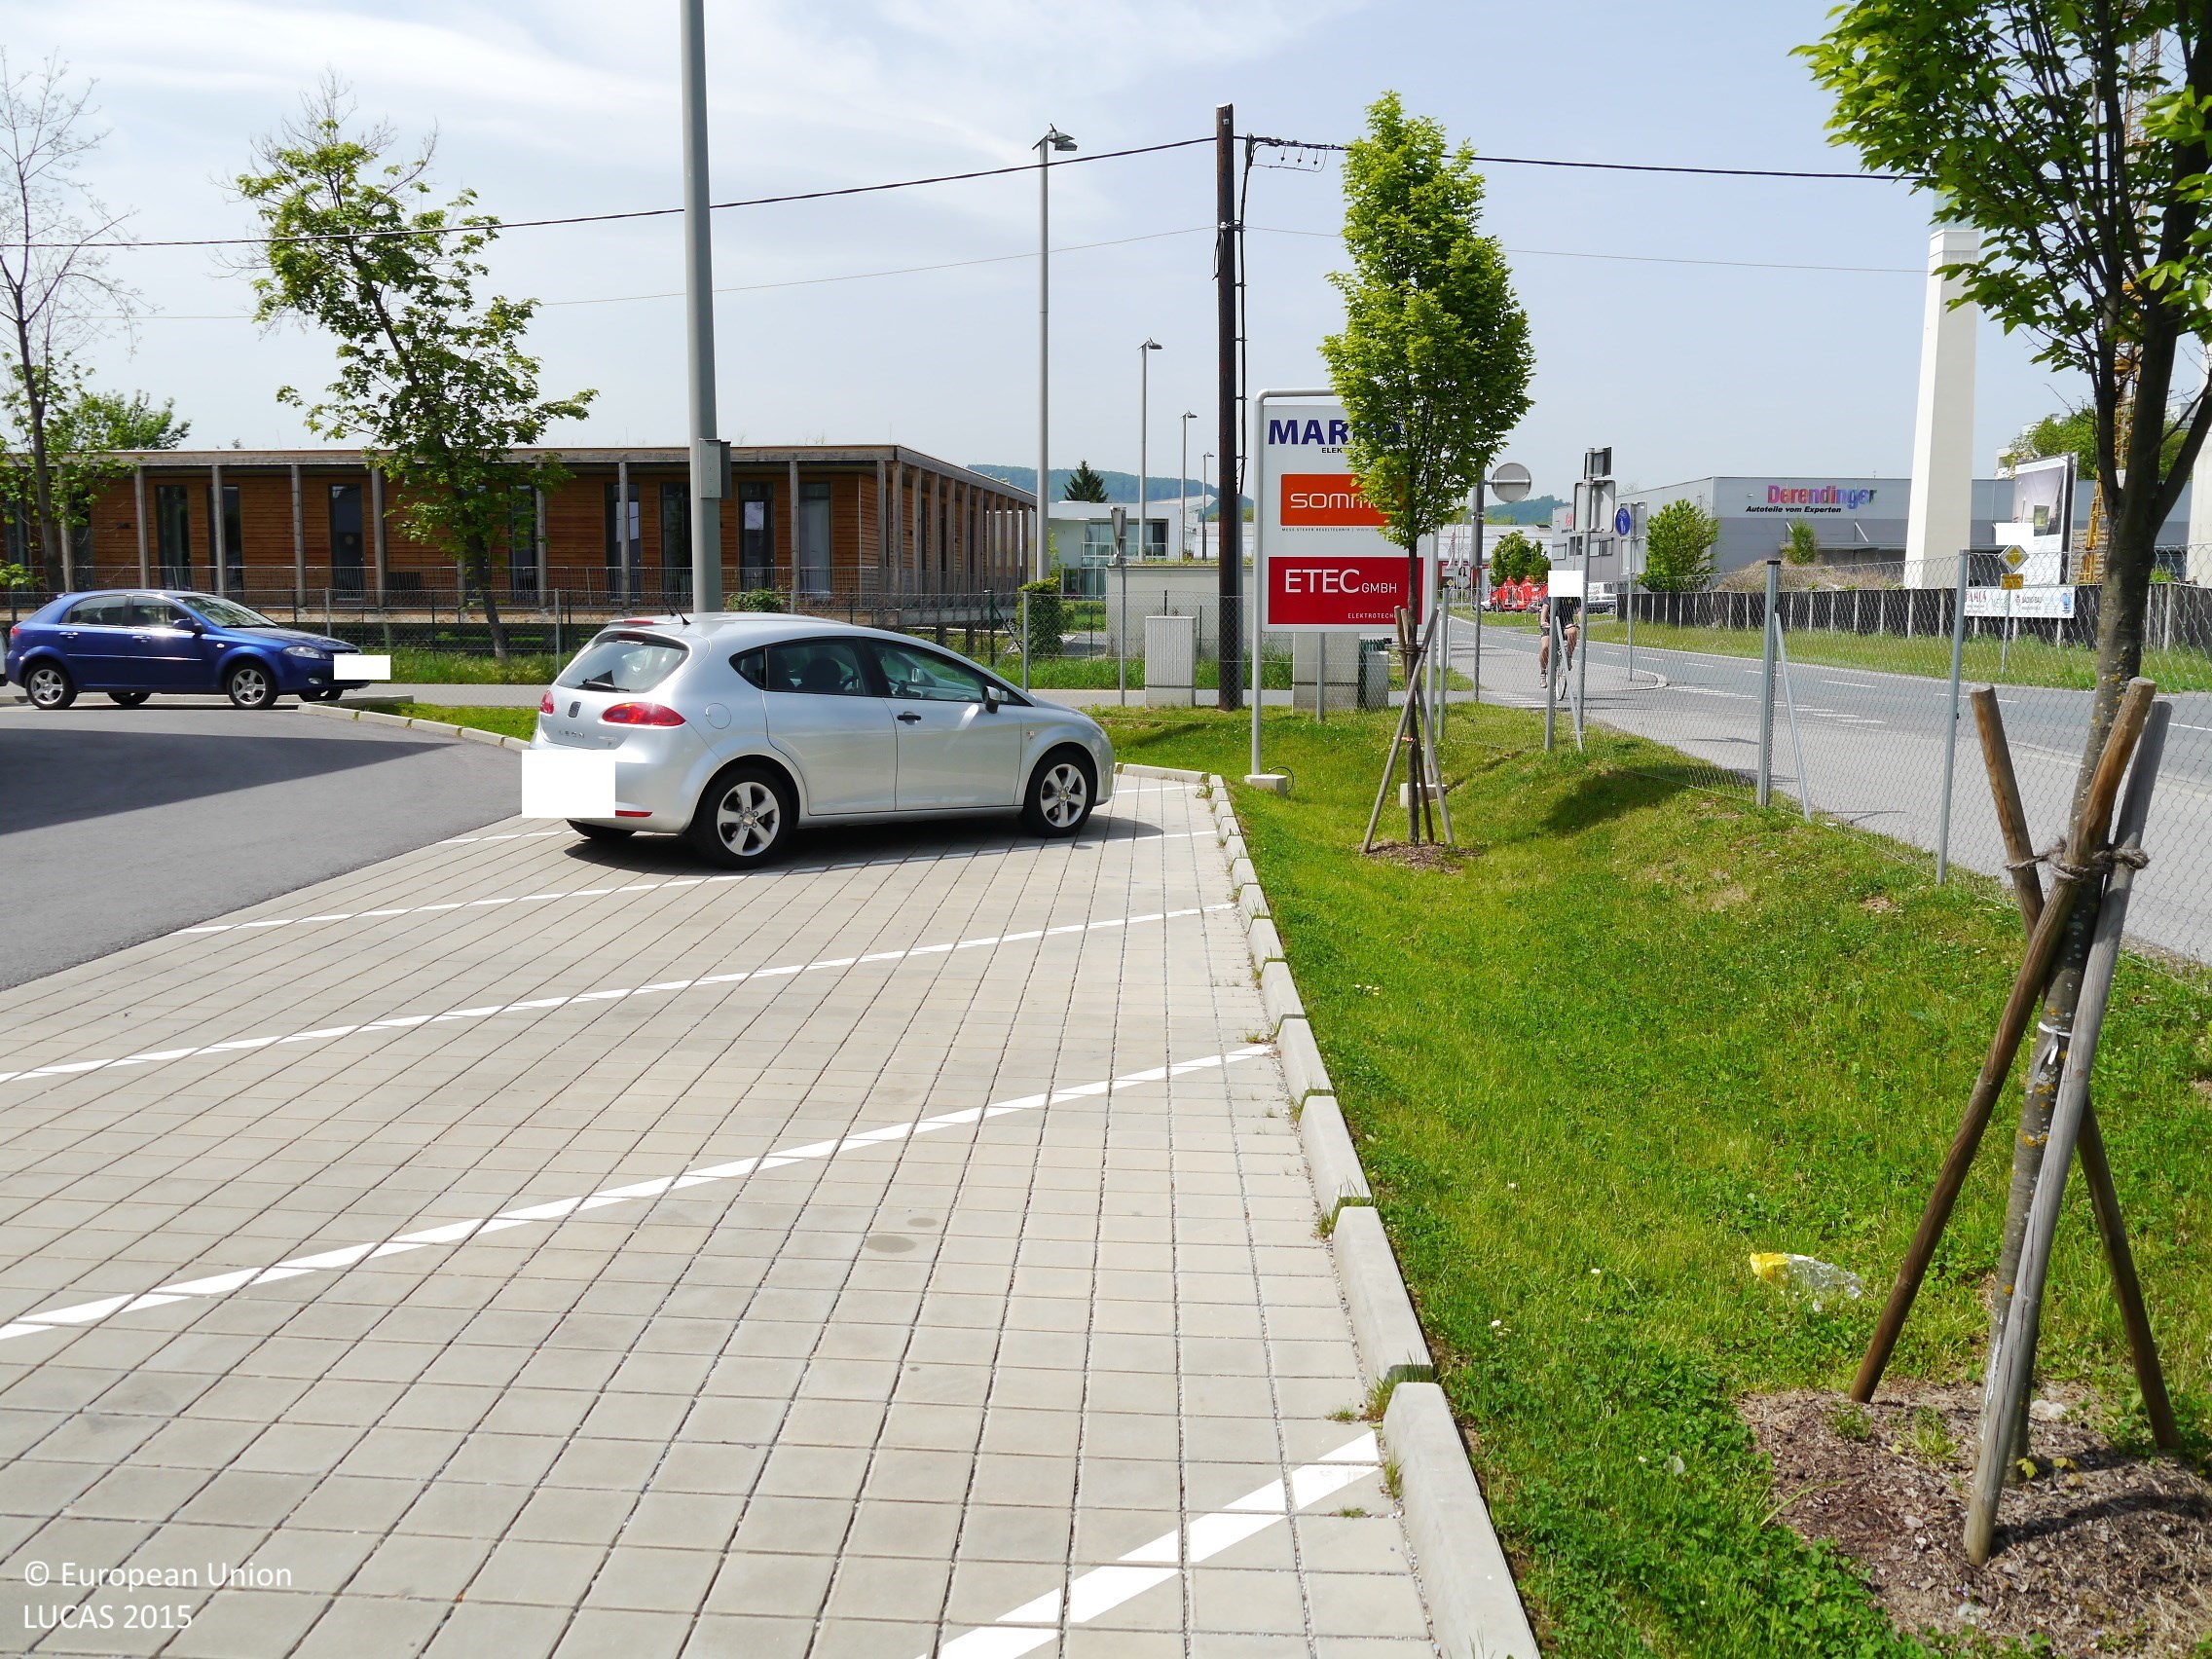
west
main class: Grassland
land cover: Grassland with sparse tree/shrub cover
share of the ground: > 75 %
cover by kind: herbaceous plants 95 %, broadleaved forest trees 5 %
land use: Commerce
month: May
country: AT
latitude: 47.0432
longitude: 15.4356
